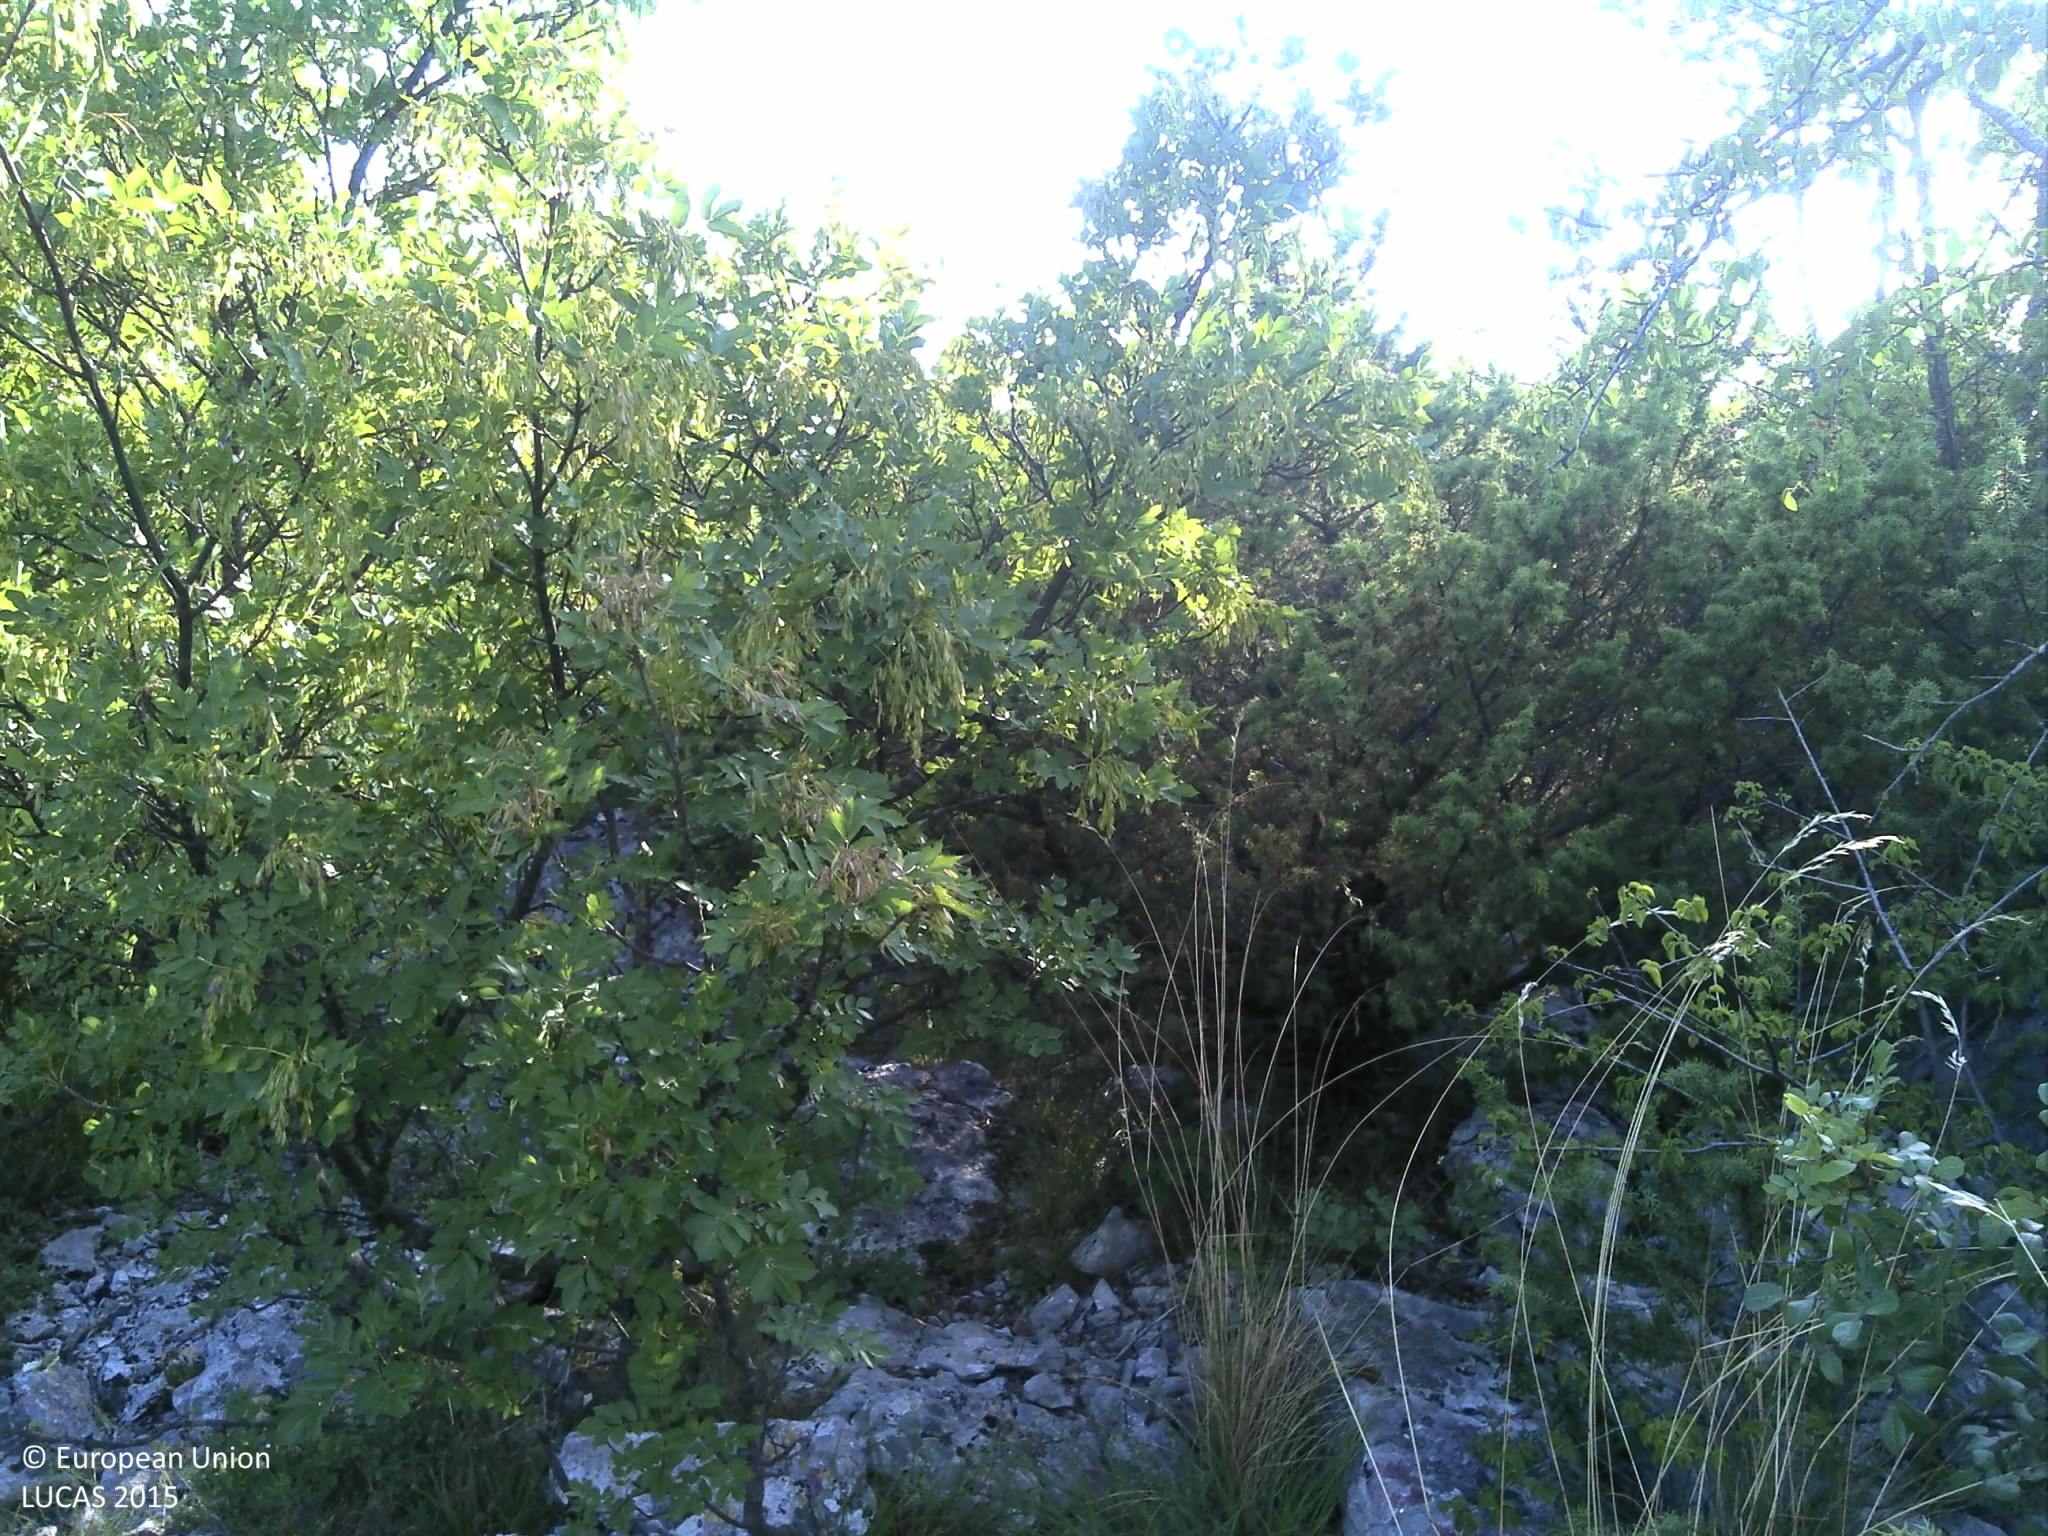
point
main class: Shrubland
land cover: Shrubland with sparse tree cover
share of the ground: > 75 %
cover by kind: shrubs 70 %, consolidated bare surface 15 %, unconsolidated bare surface 10 %, broadleaved forest trees 5 %
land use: Semi-natural and natural areas not in use
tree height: < 5 m
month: June
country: HR
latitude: 43.5985
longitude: 16.2963
